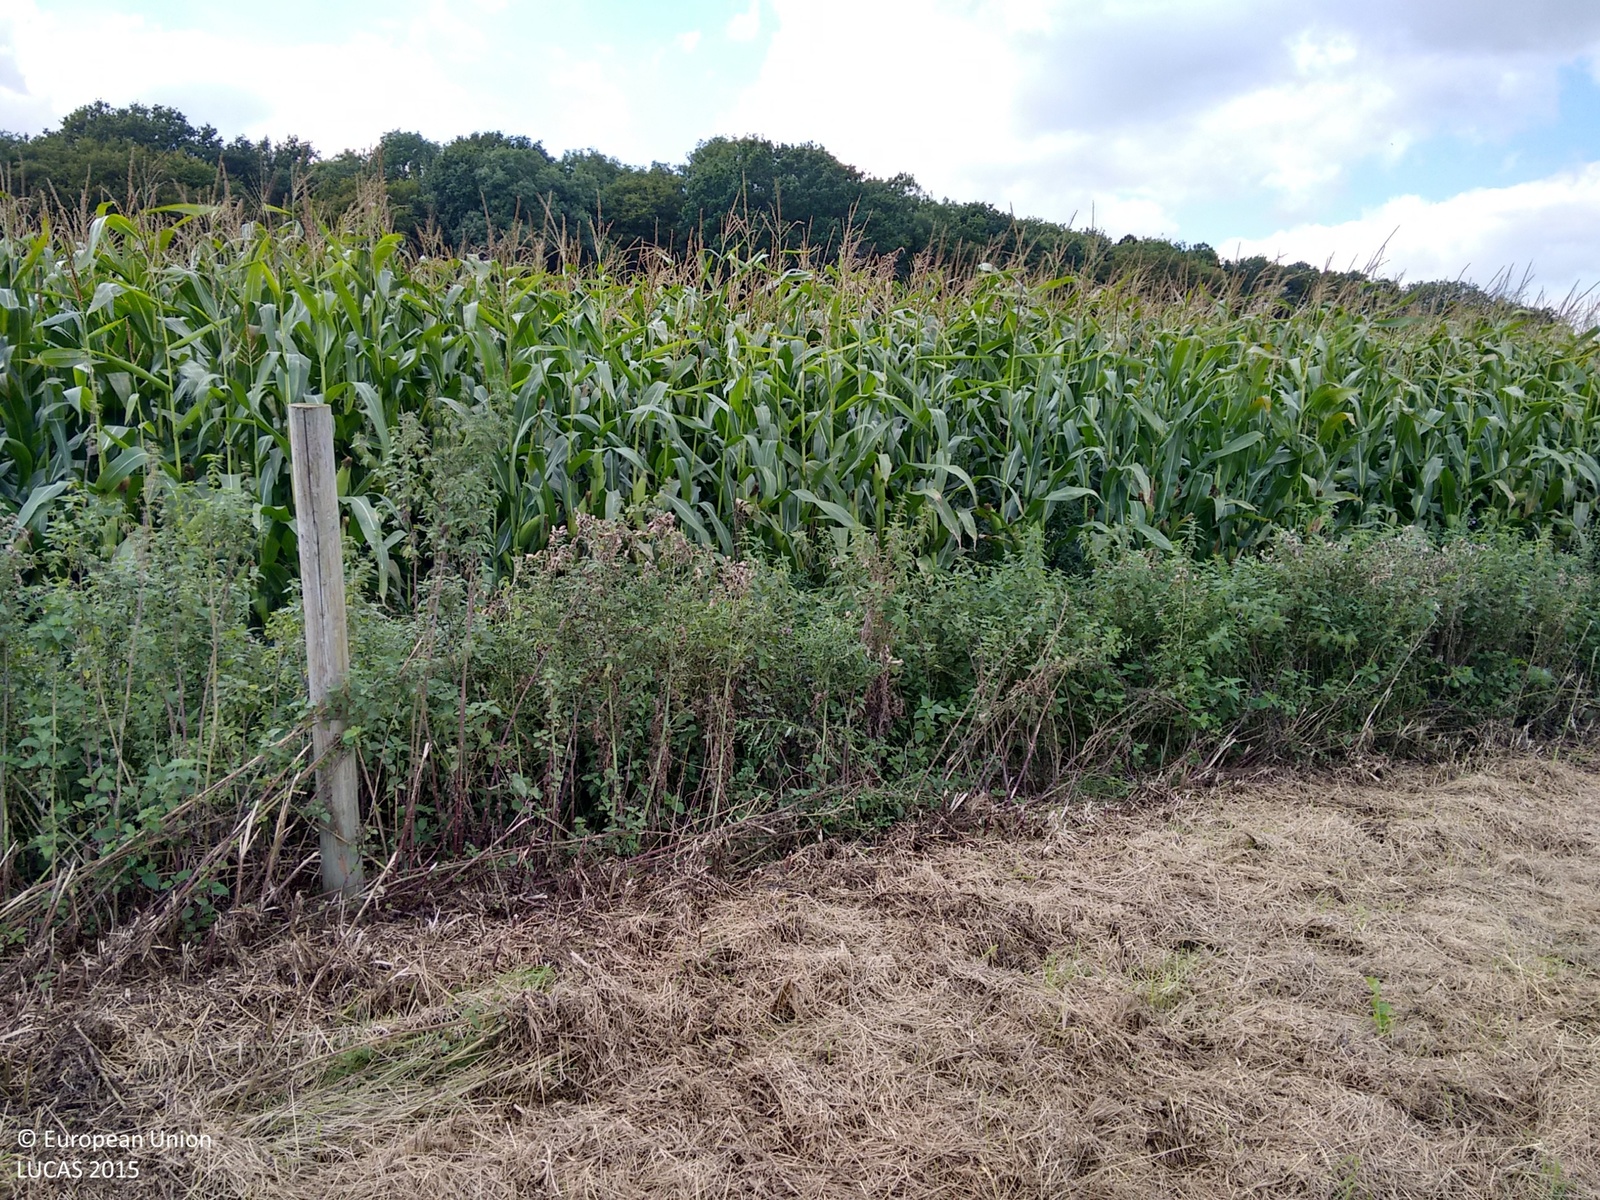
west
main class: Grassland
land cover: Grassland without tree/shrub cover
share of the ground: > 75 %
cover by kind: herbaceous plants 100 %
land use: Agriculture (excluding fallow land and kitchen gardens)
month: September
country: GB
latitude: 52.5298
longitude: 1.3268
